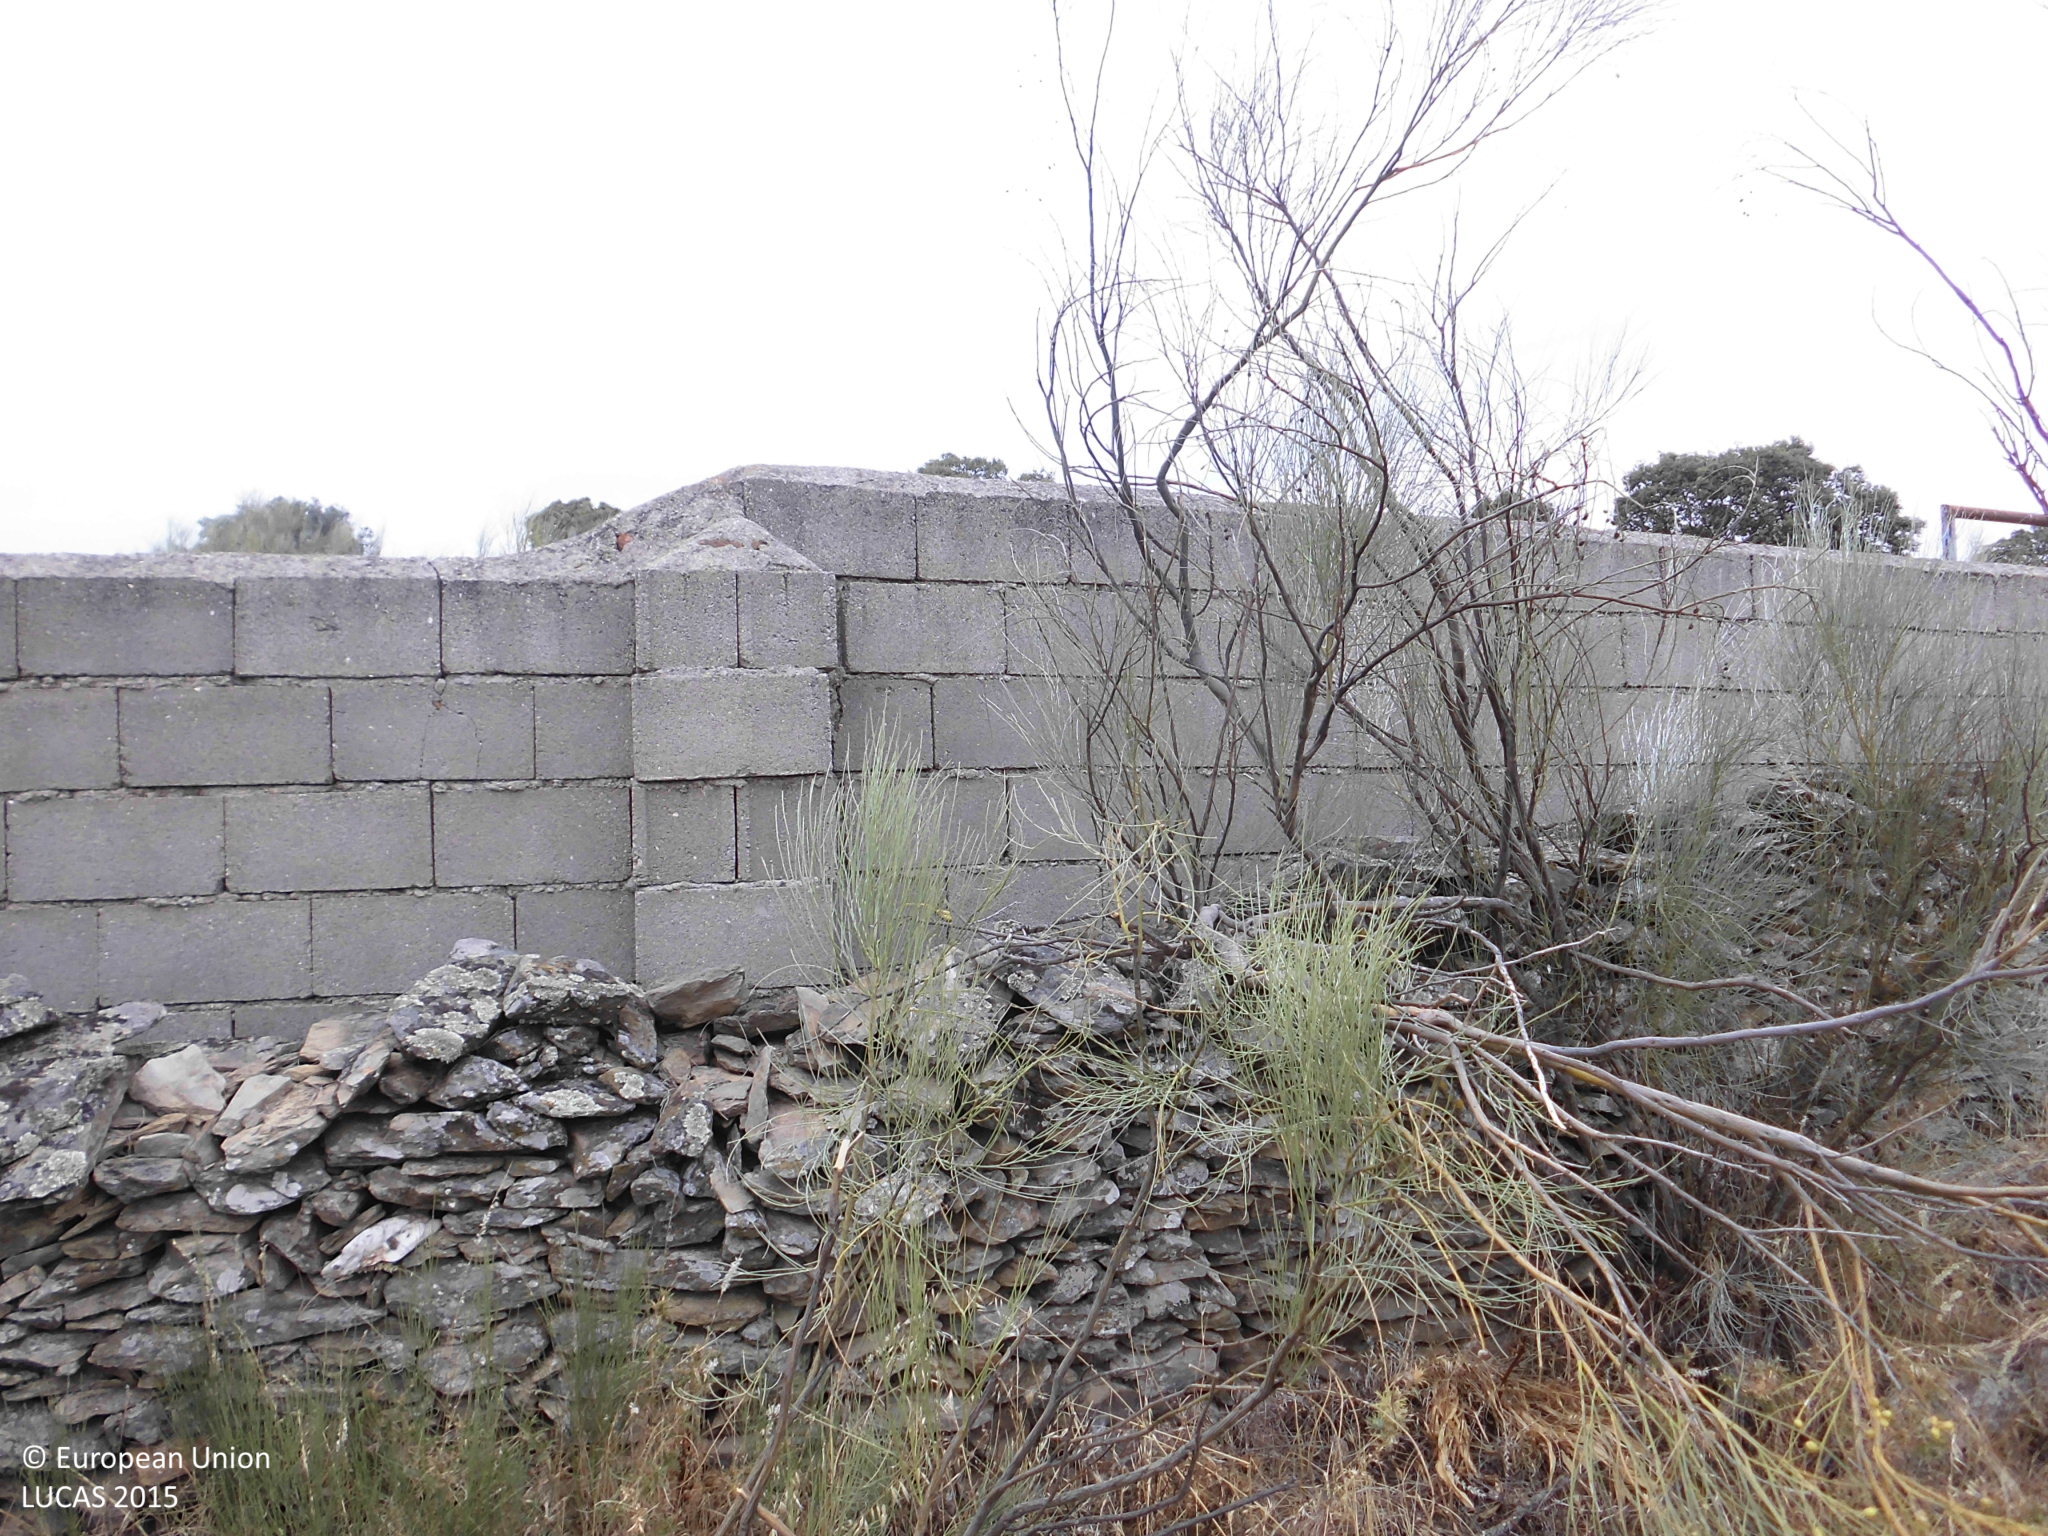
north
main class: Shrubland
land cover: Shrubland without tree cover
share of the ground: 10 - 25 %
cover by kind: herbaceous plants 75 %, shrubs 20 %, consolidated bare surface 5 %
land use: Agriculture (excluding fallow land and kitchen gardens)
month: July
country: ES
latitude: 39.8934
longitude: -6.4856
